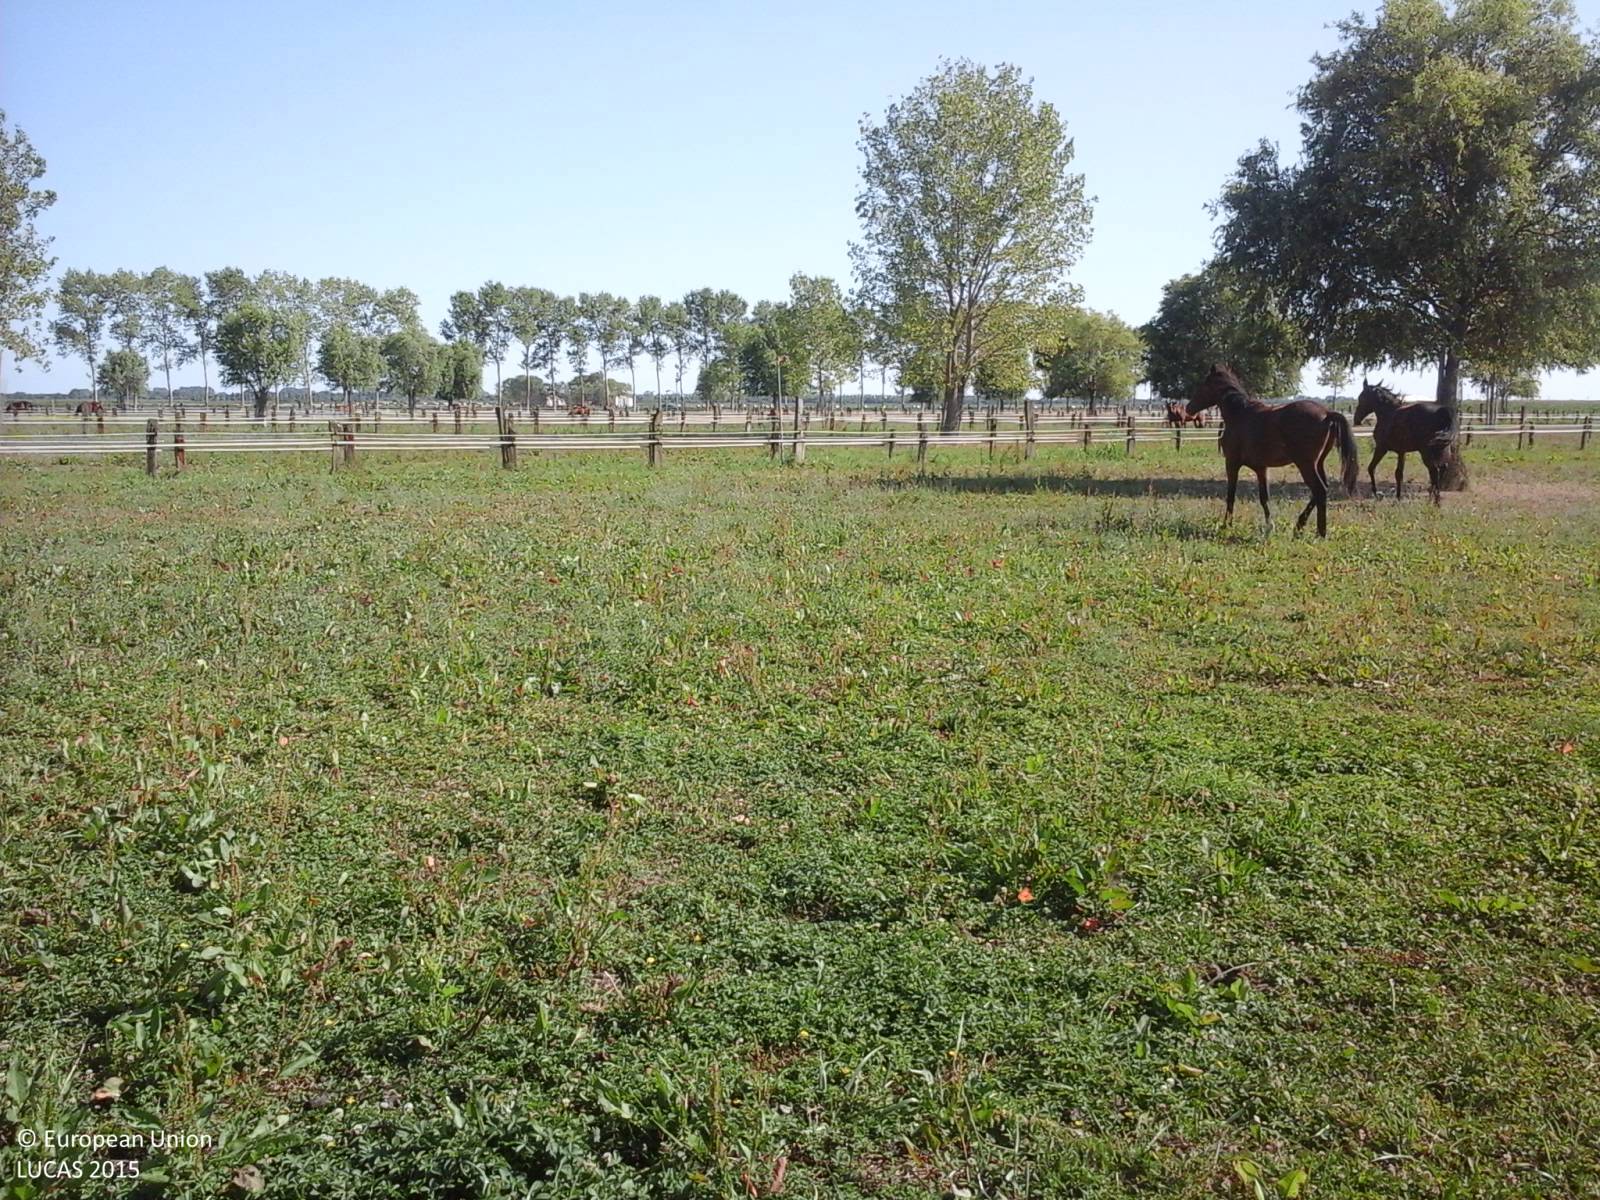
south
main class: Grassland
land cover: Grassland without tree/shrub cover
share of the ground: > 75 %
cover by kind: herbaceous plants 100 %
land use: Agriculture (excluding fallow land and kitchen gardens)
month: July
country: IT
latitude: 45.6771
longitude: 13.0386
